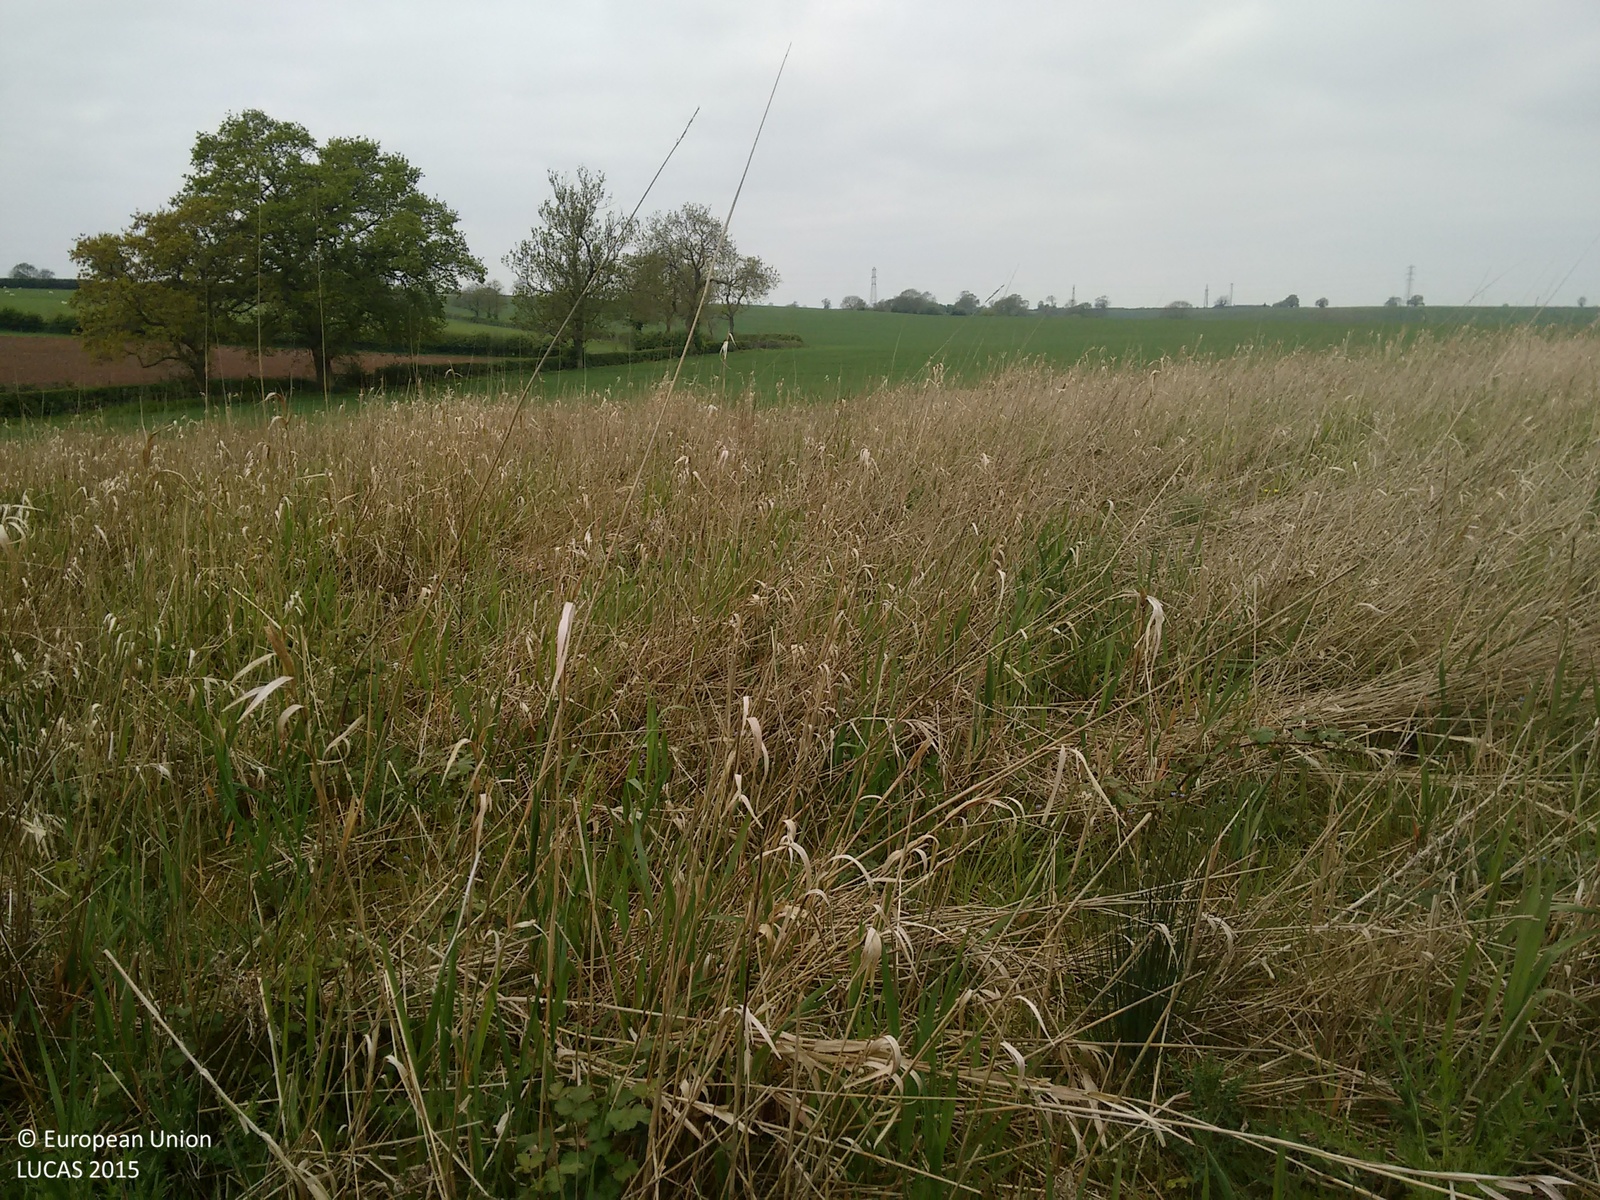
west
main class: Grassland
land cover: Grassland without tree/shrub cover
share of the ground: > 75 %
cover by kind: herbaceous plants 95 %, shrubs 5 %
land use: Agriculture (excluding fallow land and kitchen gardens)
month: May
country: GB
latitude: 52.4202
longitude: -1.2670
